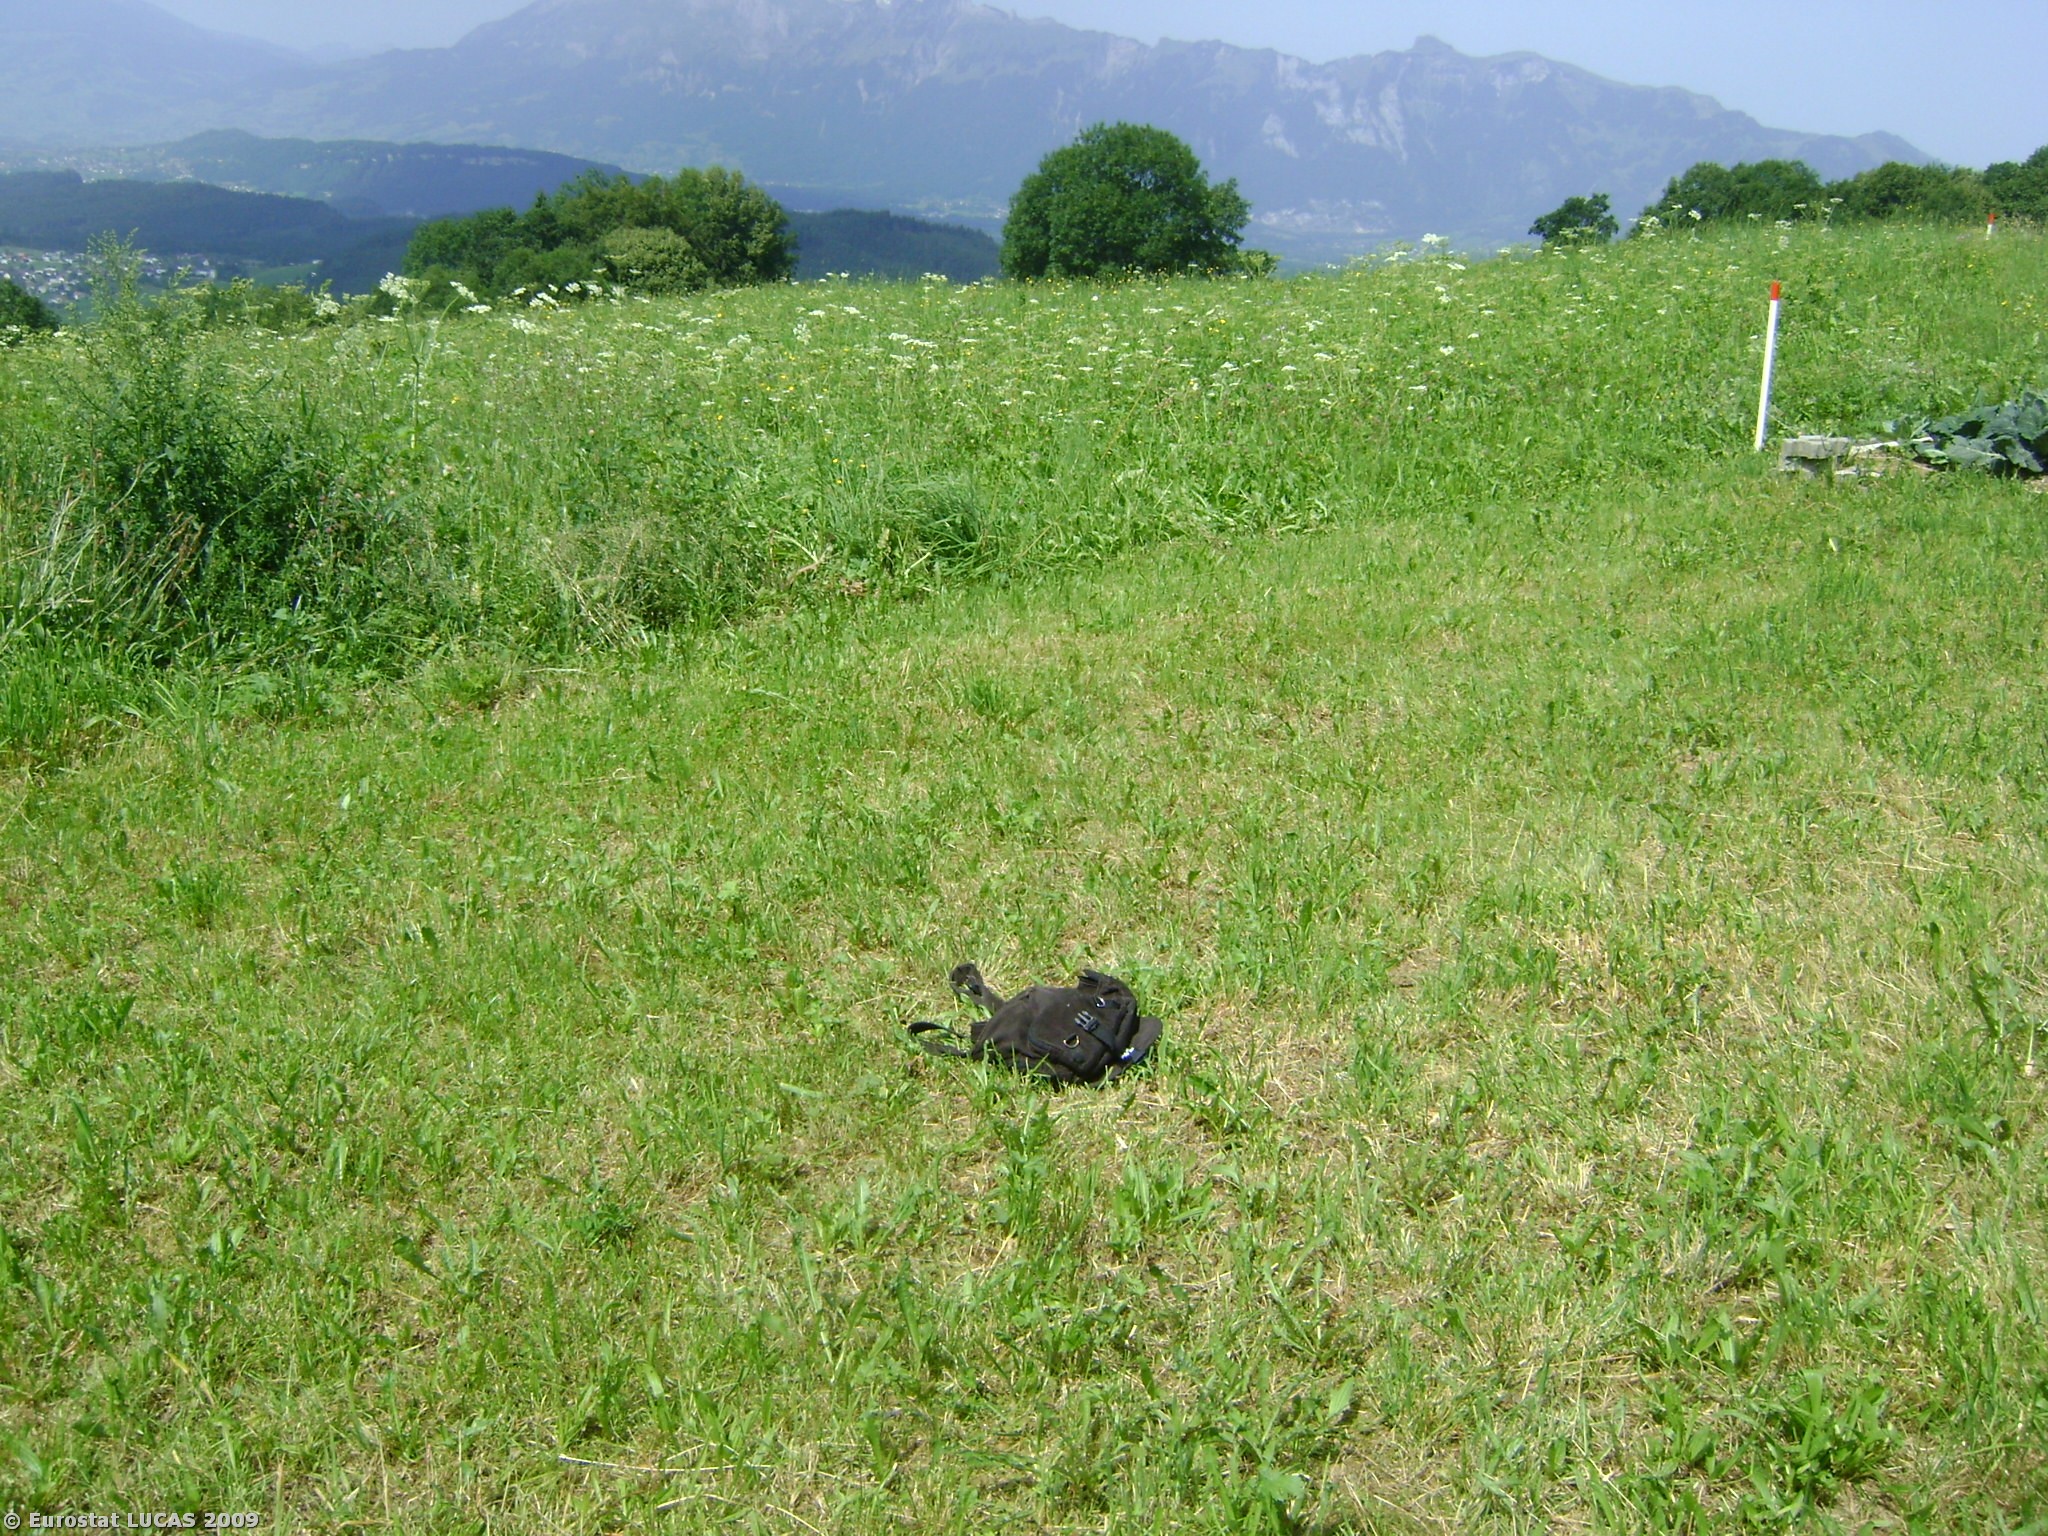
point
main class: Grassland
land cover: Grassland without tree/shrub cover
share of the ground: > 75 %
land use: Agriculture (excluding fallow land and kitchen gardens)
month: July
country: AT
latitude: 47.2511
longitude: 9.6700
